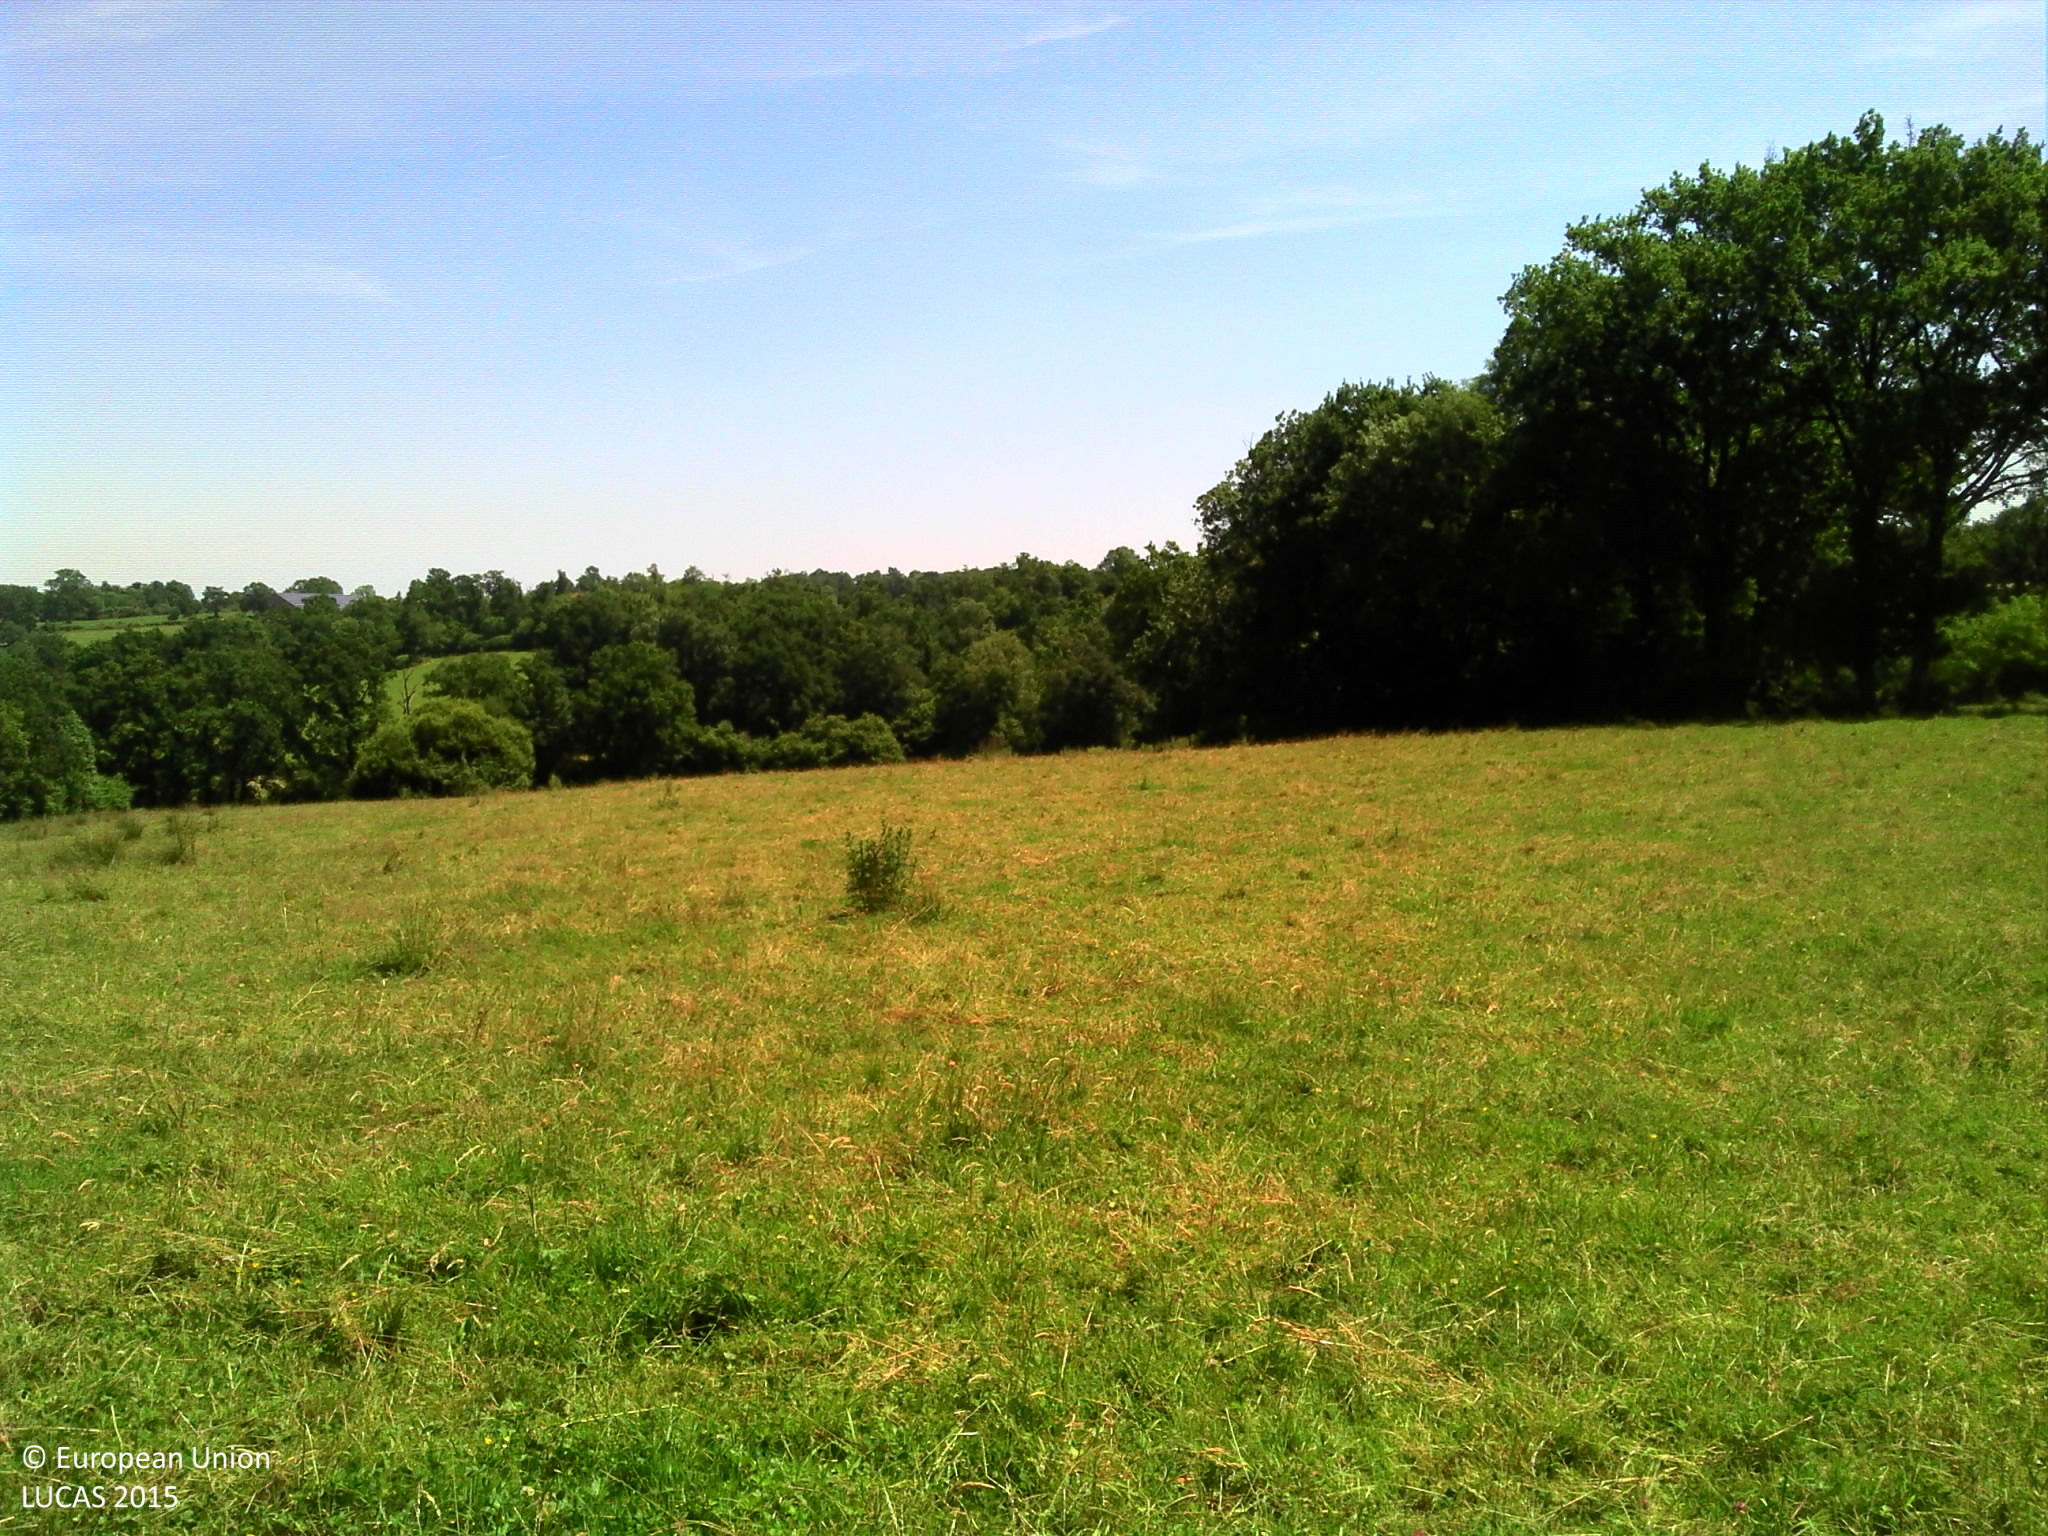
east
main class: Grassland
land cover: Grassland without tree/shrub cover
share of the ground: > 75 %
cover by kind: herbaceous plants 100 %
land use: Agriculture (excluding fallow land and kitchen gardens)
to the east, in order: Grassland without tree/shrub cover; Lines of trees; Grassland without tree/shrub cover; Lines of trees; Grassland without tree/shrub cover; Lines of trees; Fences; Grassland without tree/shrub cover; Lines of trees; Grassland without tree/shrub cover
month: June
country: FR
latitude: 45.8278
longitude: 0.6022
